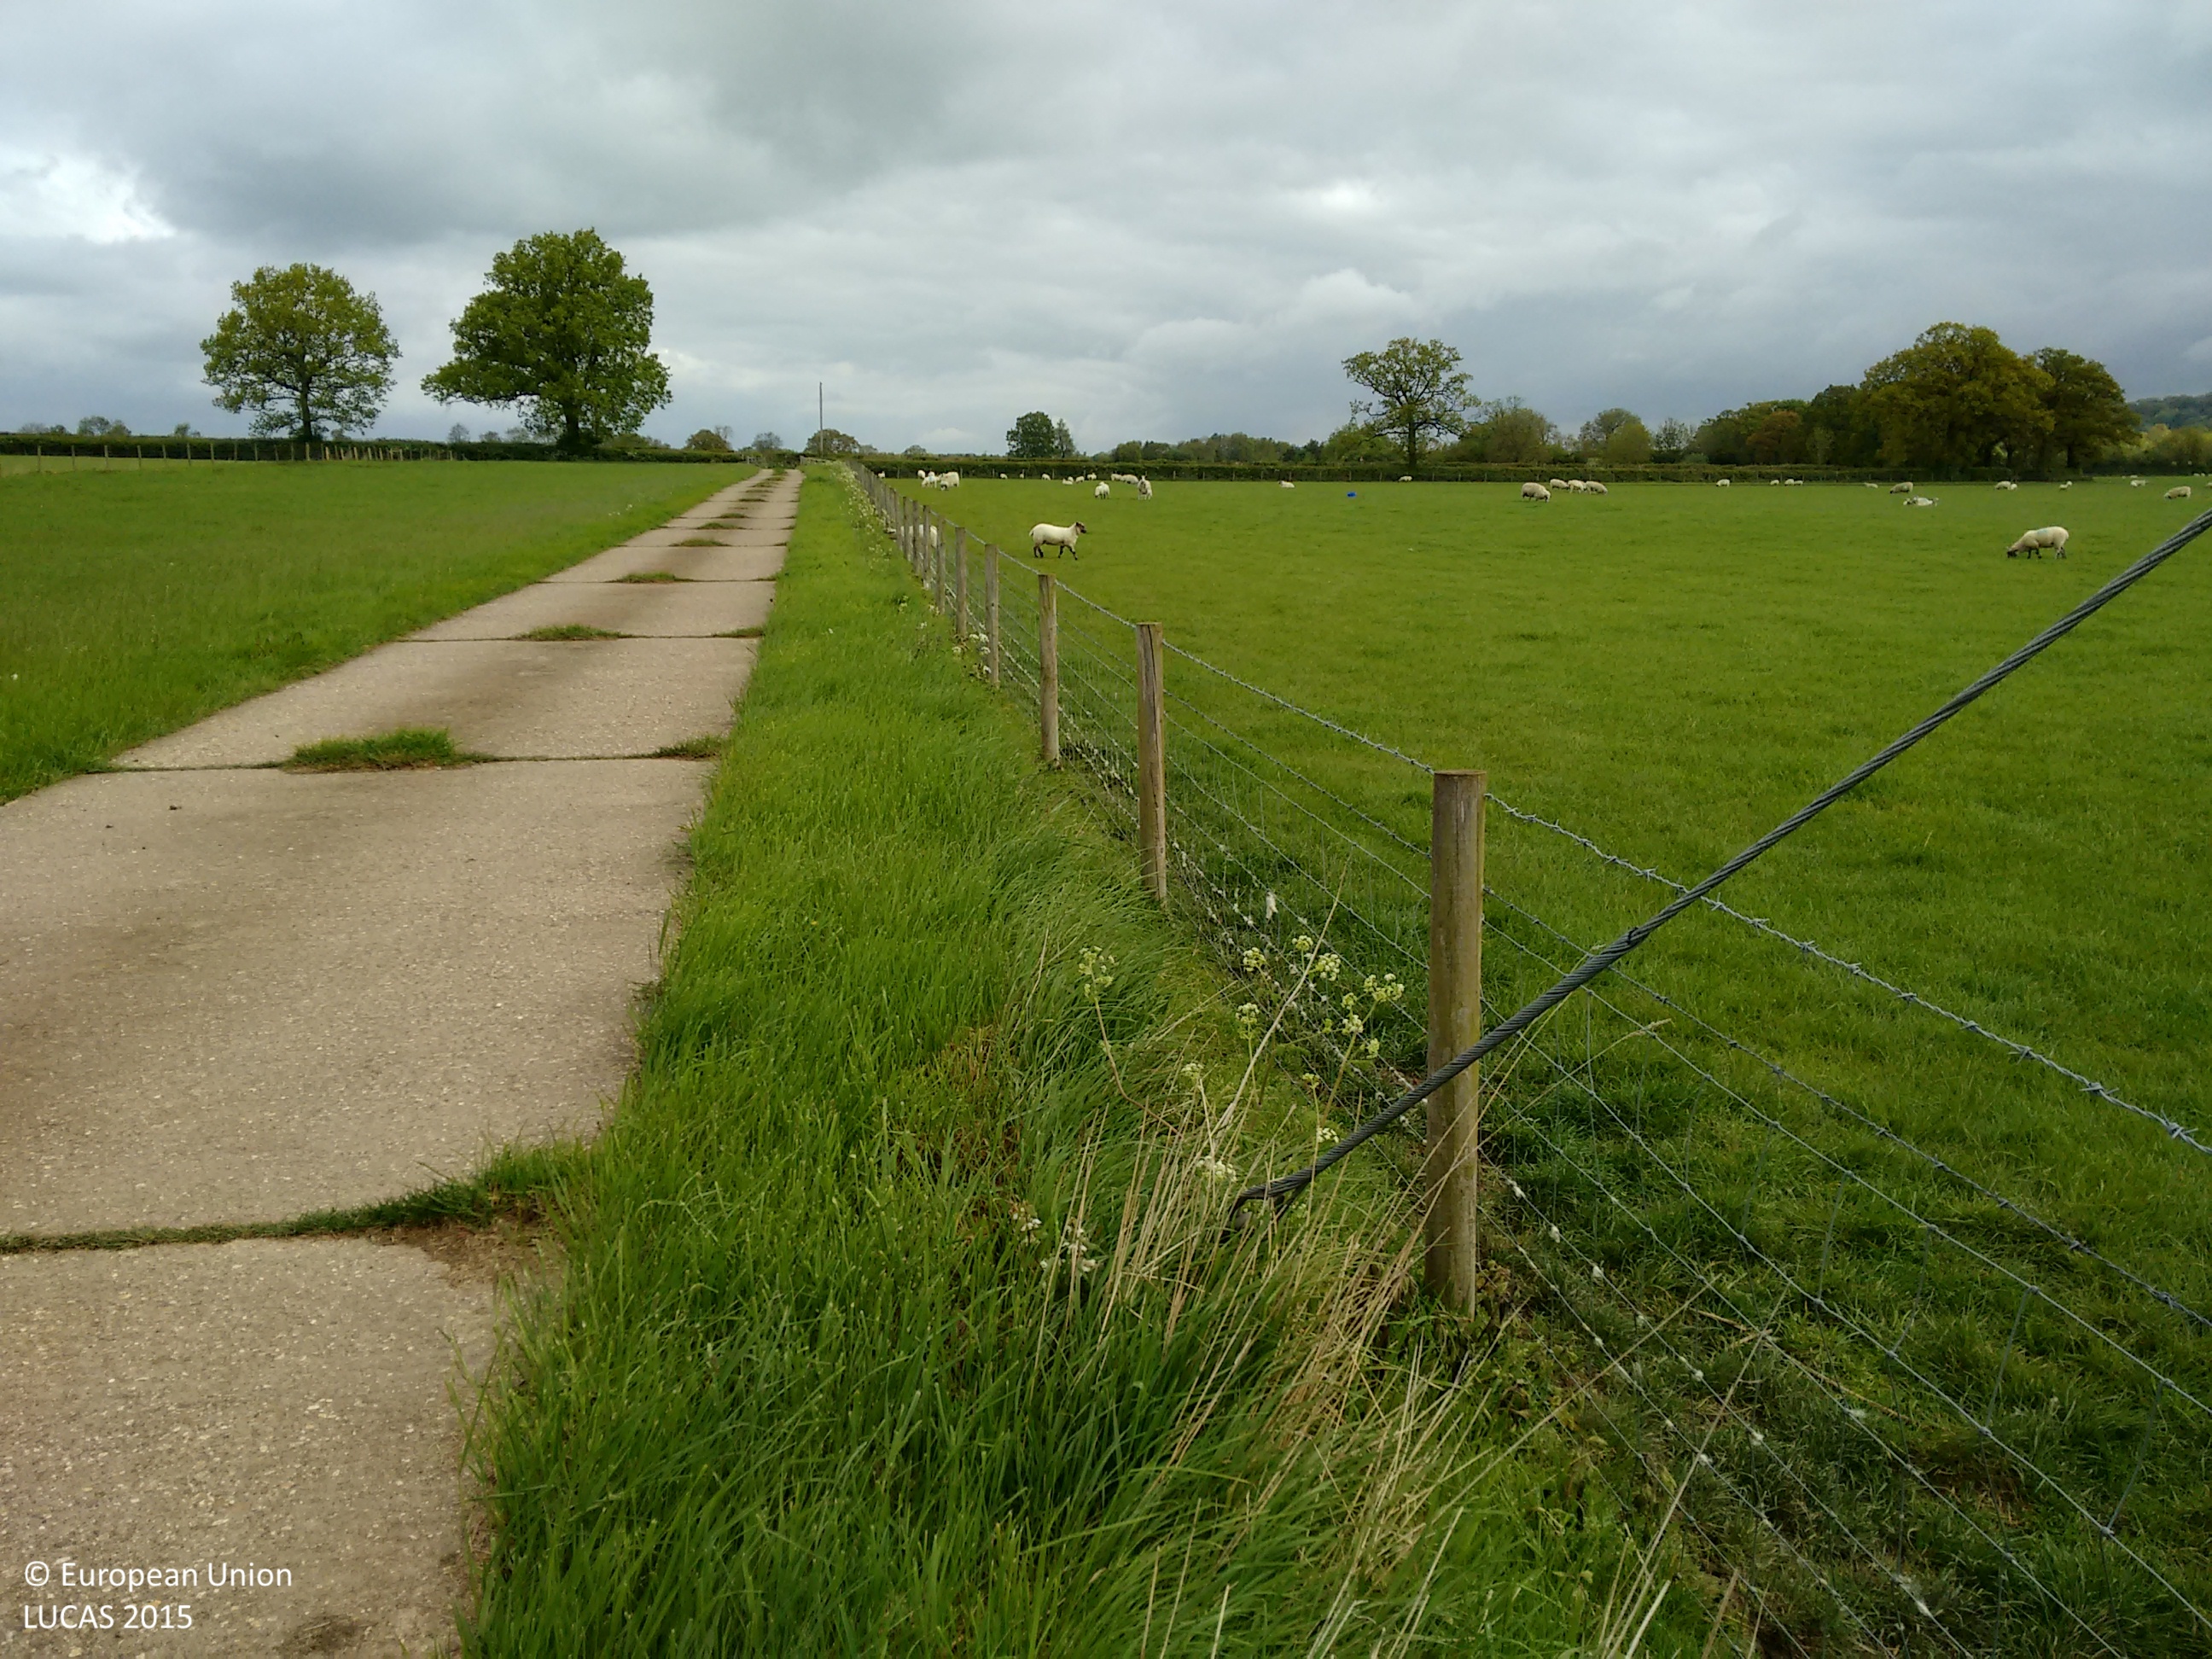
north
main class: Grassland
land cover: Grassland without tree/shrub cover
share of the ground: > 75 %
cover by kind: herbaceous plants 100 %
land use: Agriculture (excluding fallow land and kitchen gardens)
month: May
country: GB
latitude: 52.1992
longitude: -1.2995
